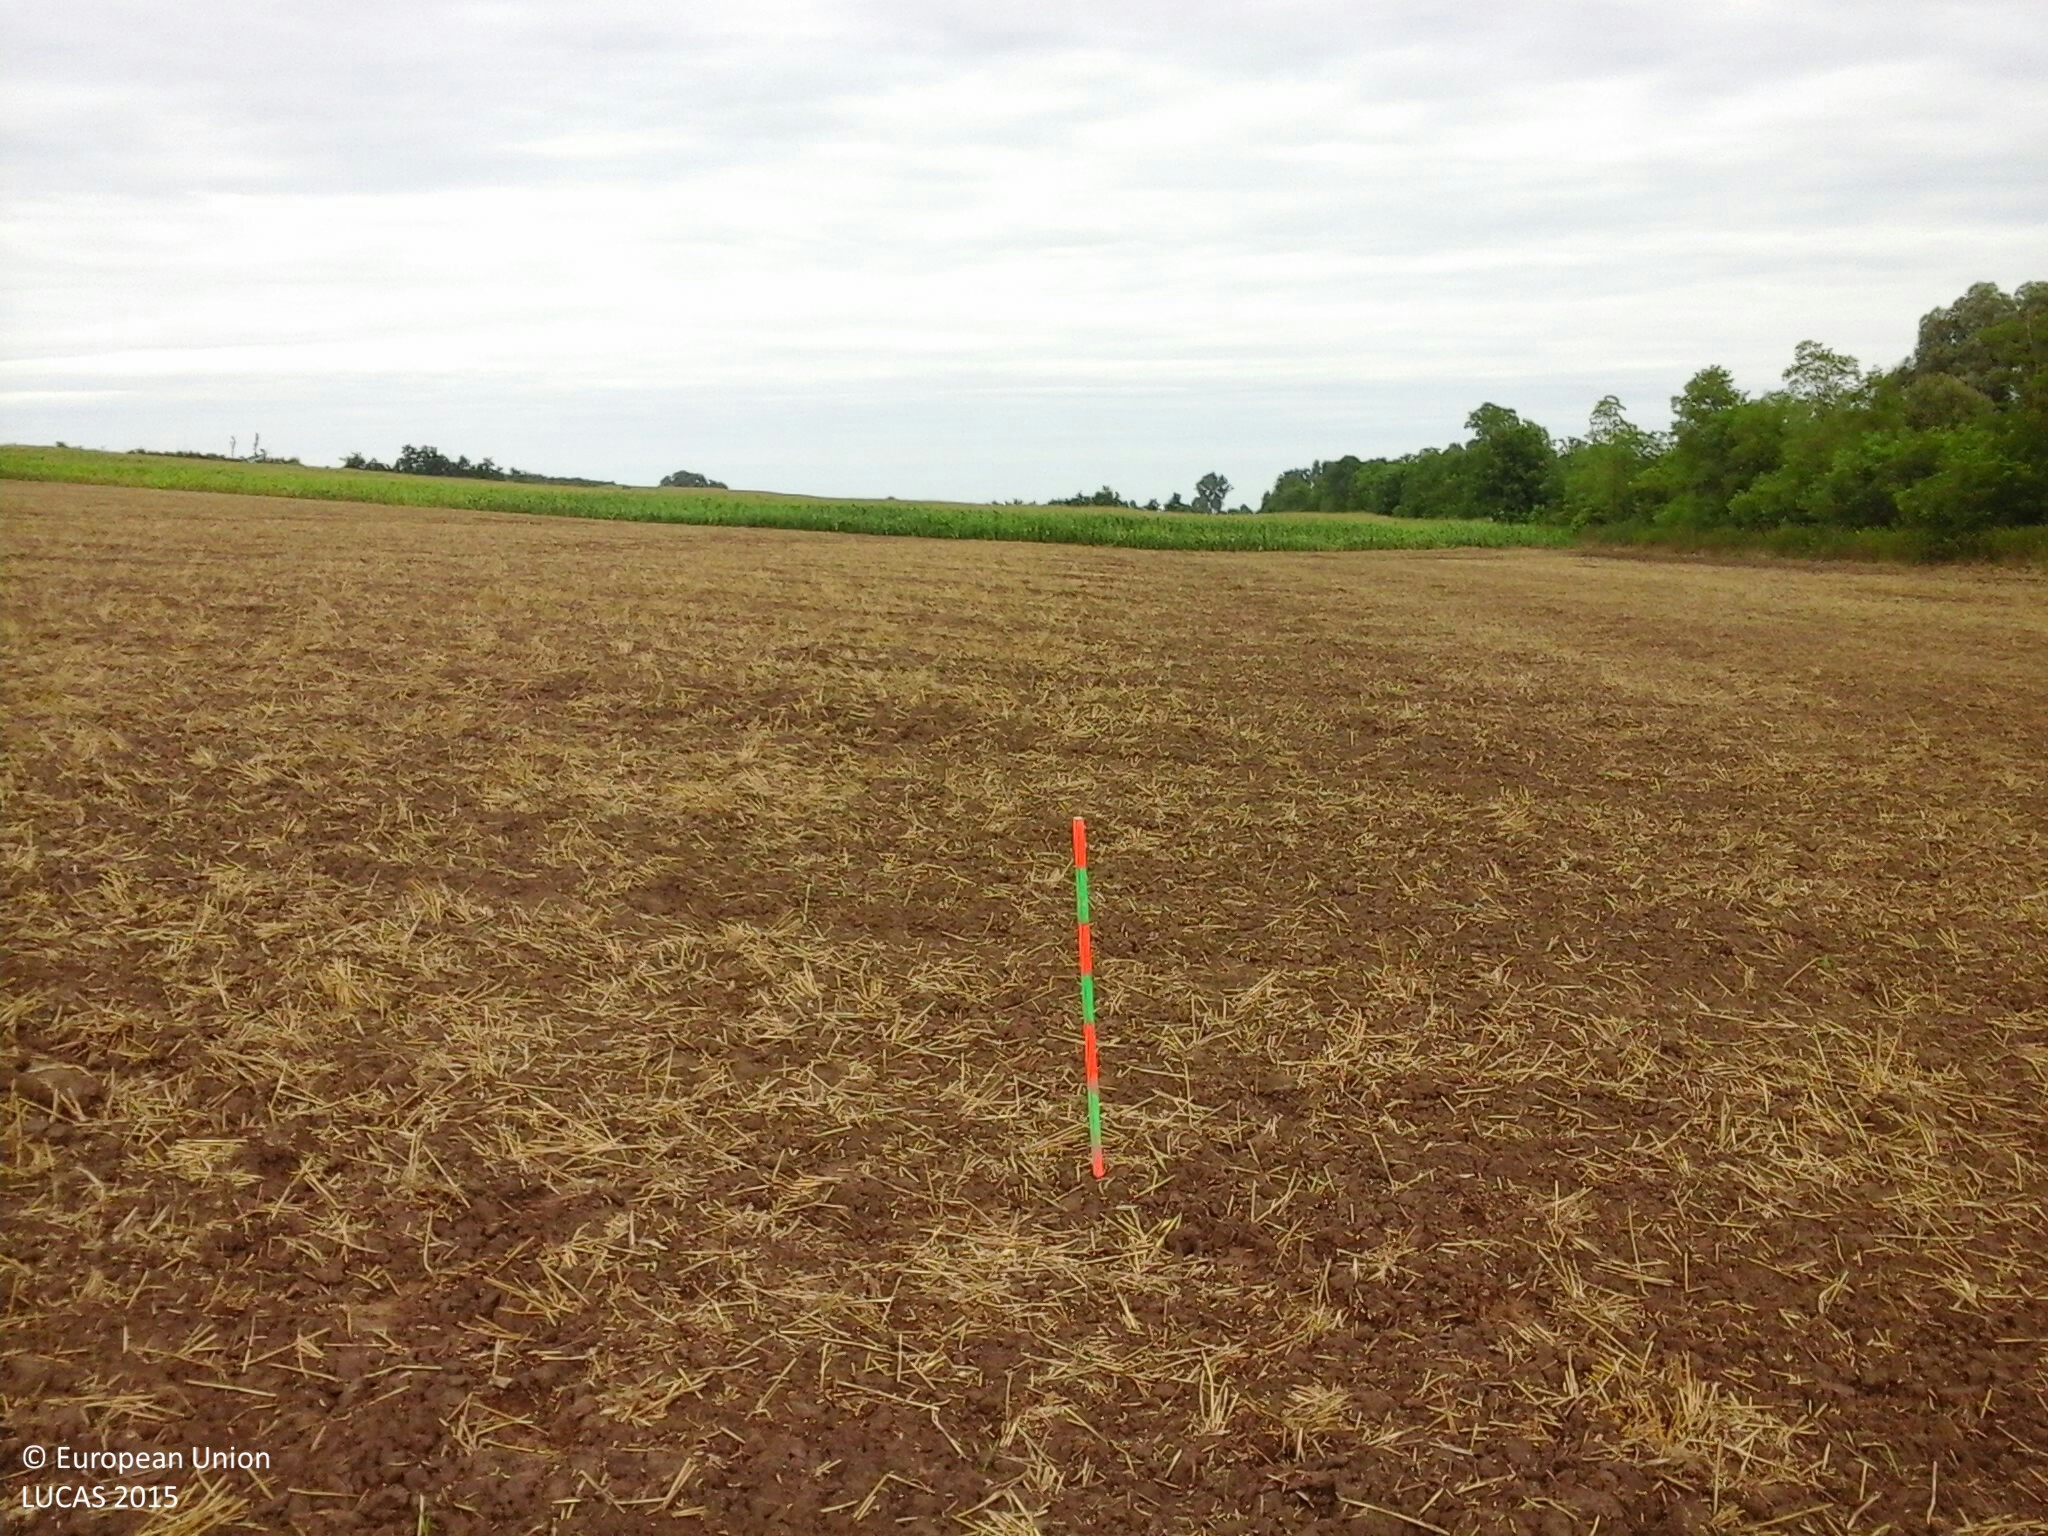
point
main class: Cropland
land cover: Common wheat
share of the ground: < 10 %
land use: Agriculture (excluding fallow land and kitchen gardens)
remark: Harvested field
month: July
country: HU
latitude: 46.6567
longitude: 17.8873
